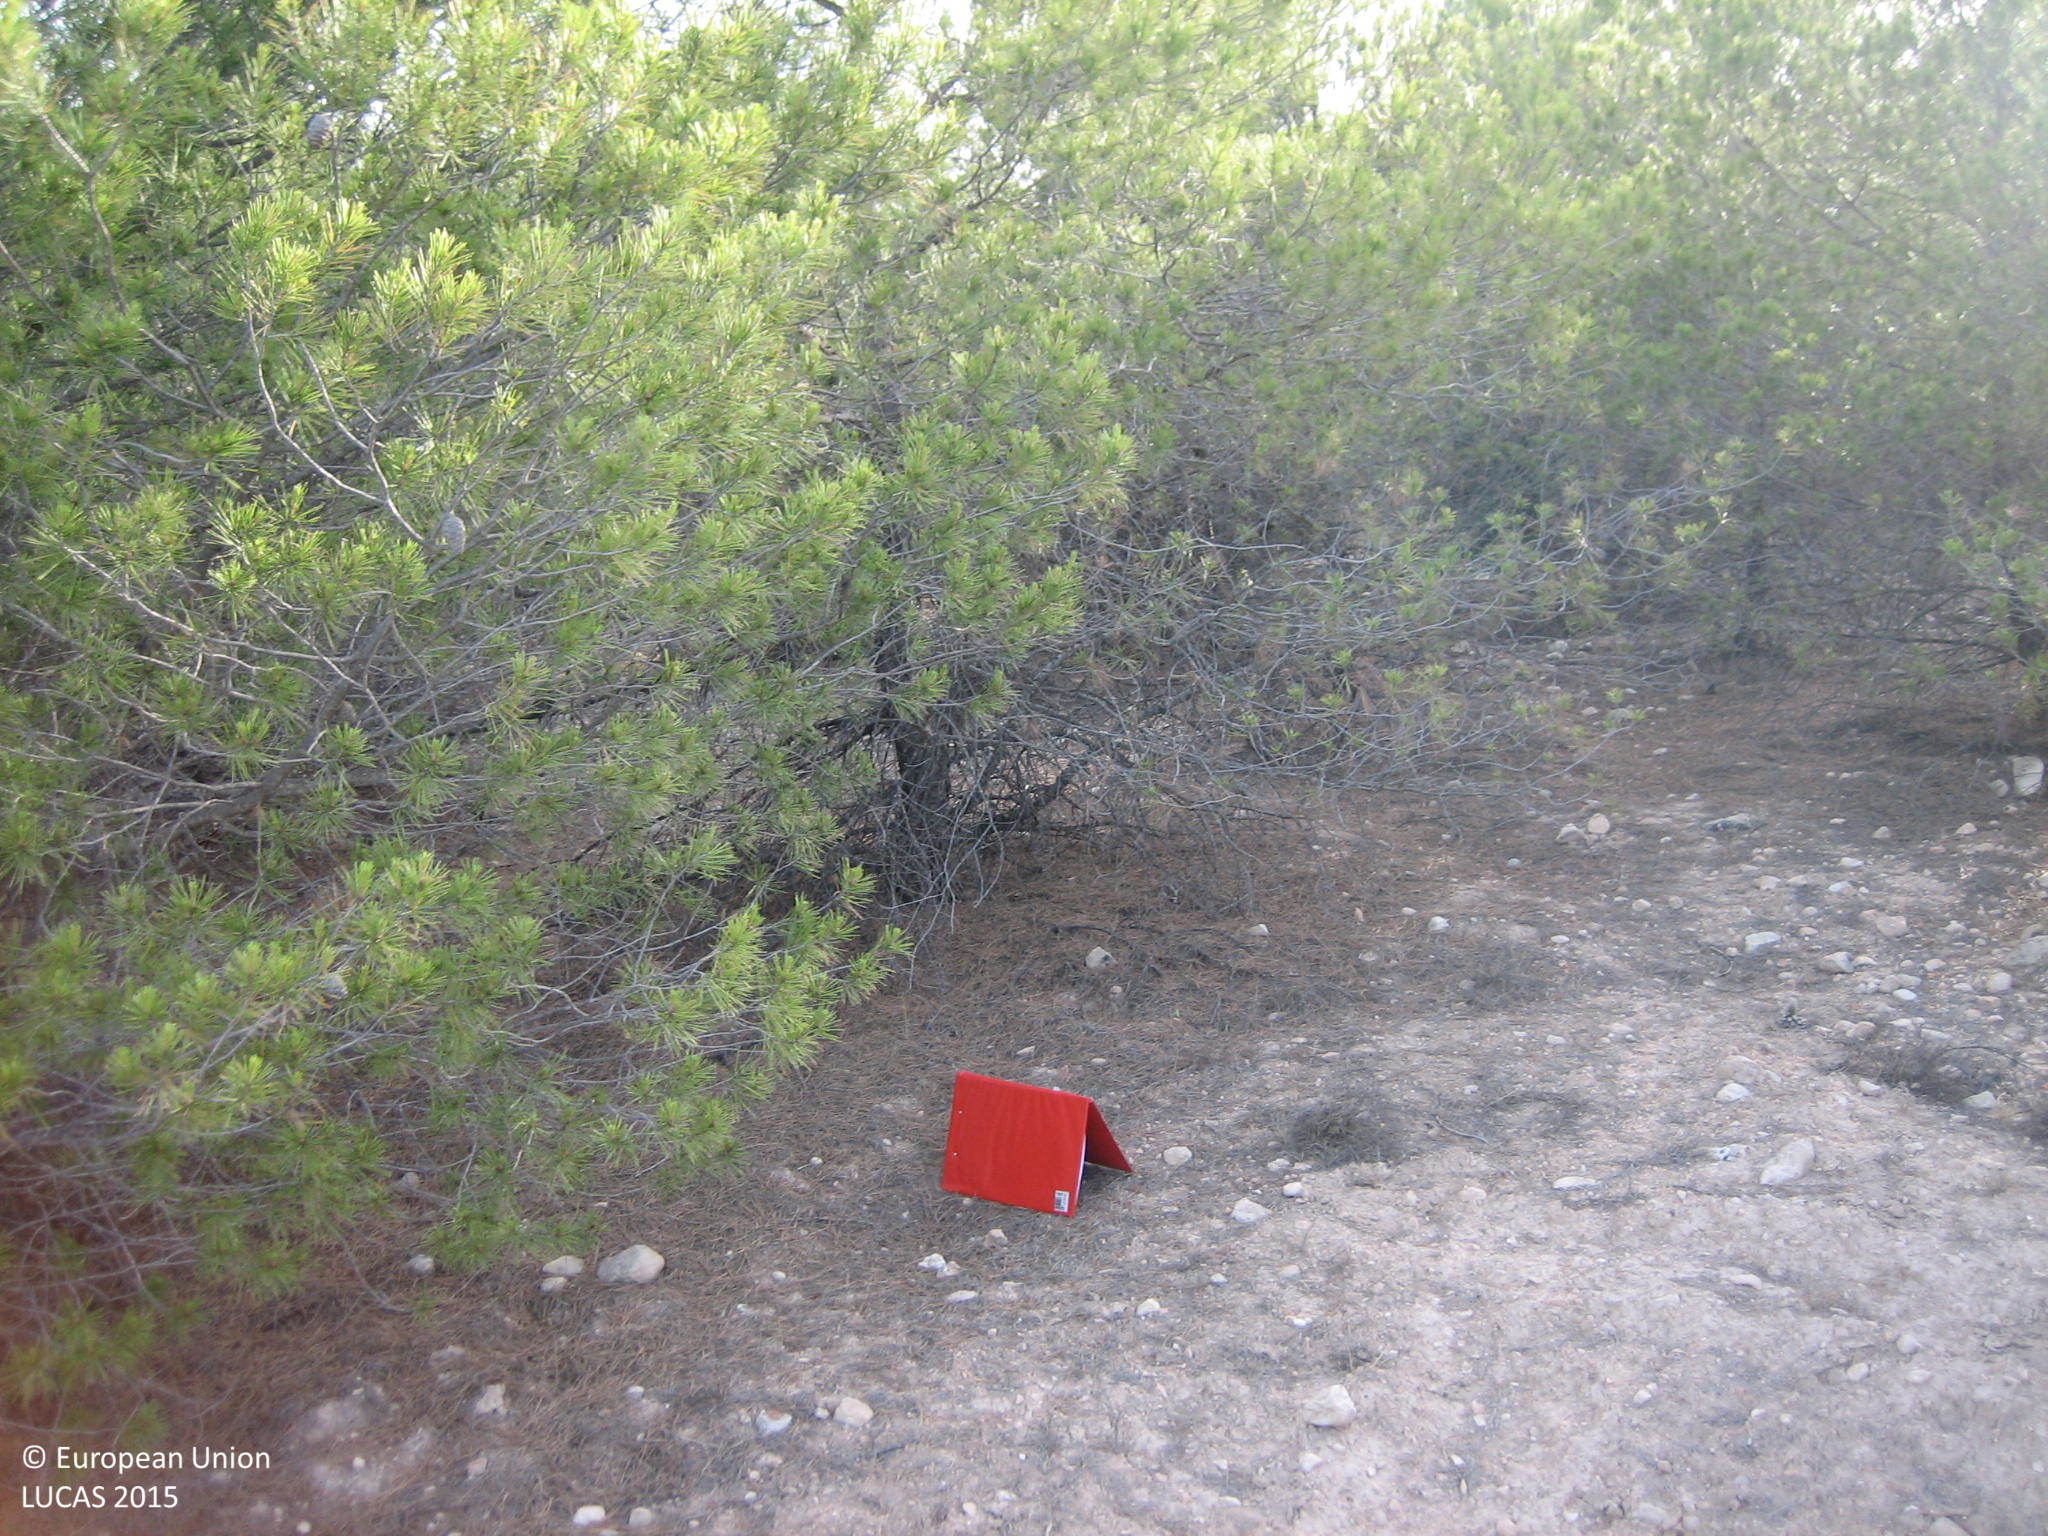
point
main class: Woodland
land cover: Pine dominated coniferous woodland
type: coniferous forest of the mediterranean region
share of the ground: > 75 %
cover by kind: coniferous forest trees 80 %, unconsolidated bare surface 20 %
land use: Forestry
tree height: < 5 m
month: July
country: ES
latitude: 37.7429
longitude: -2.3688
